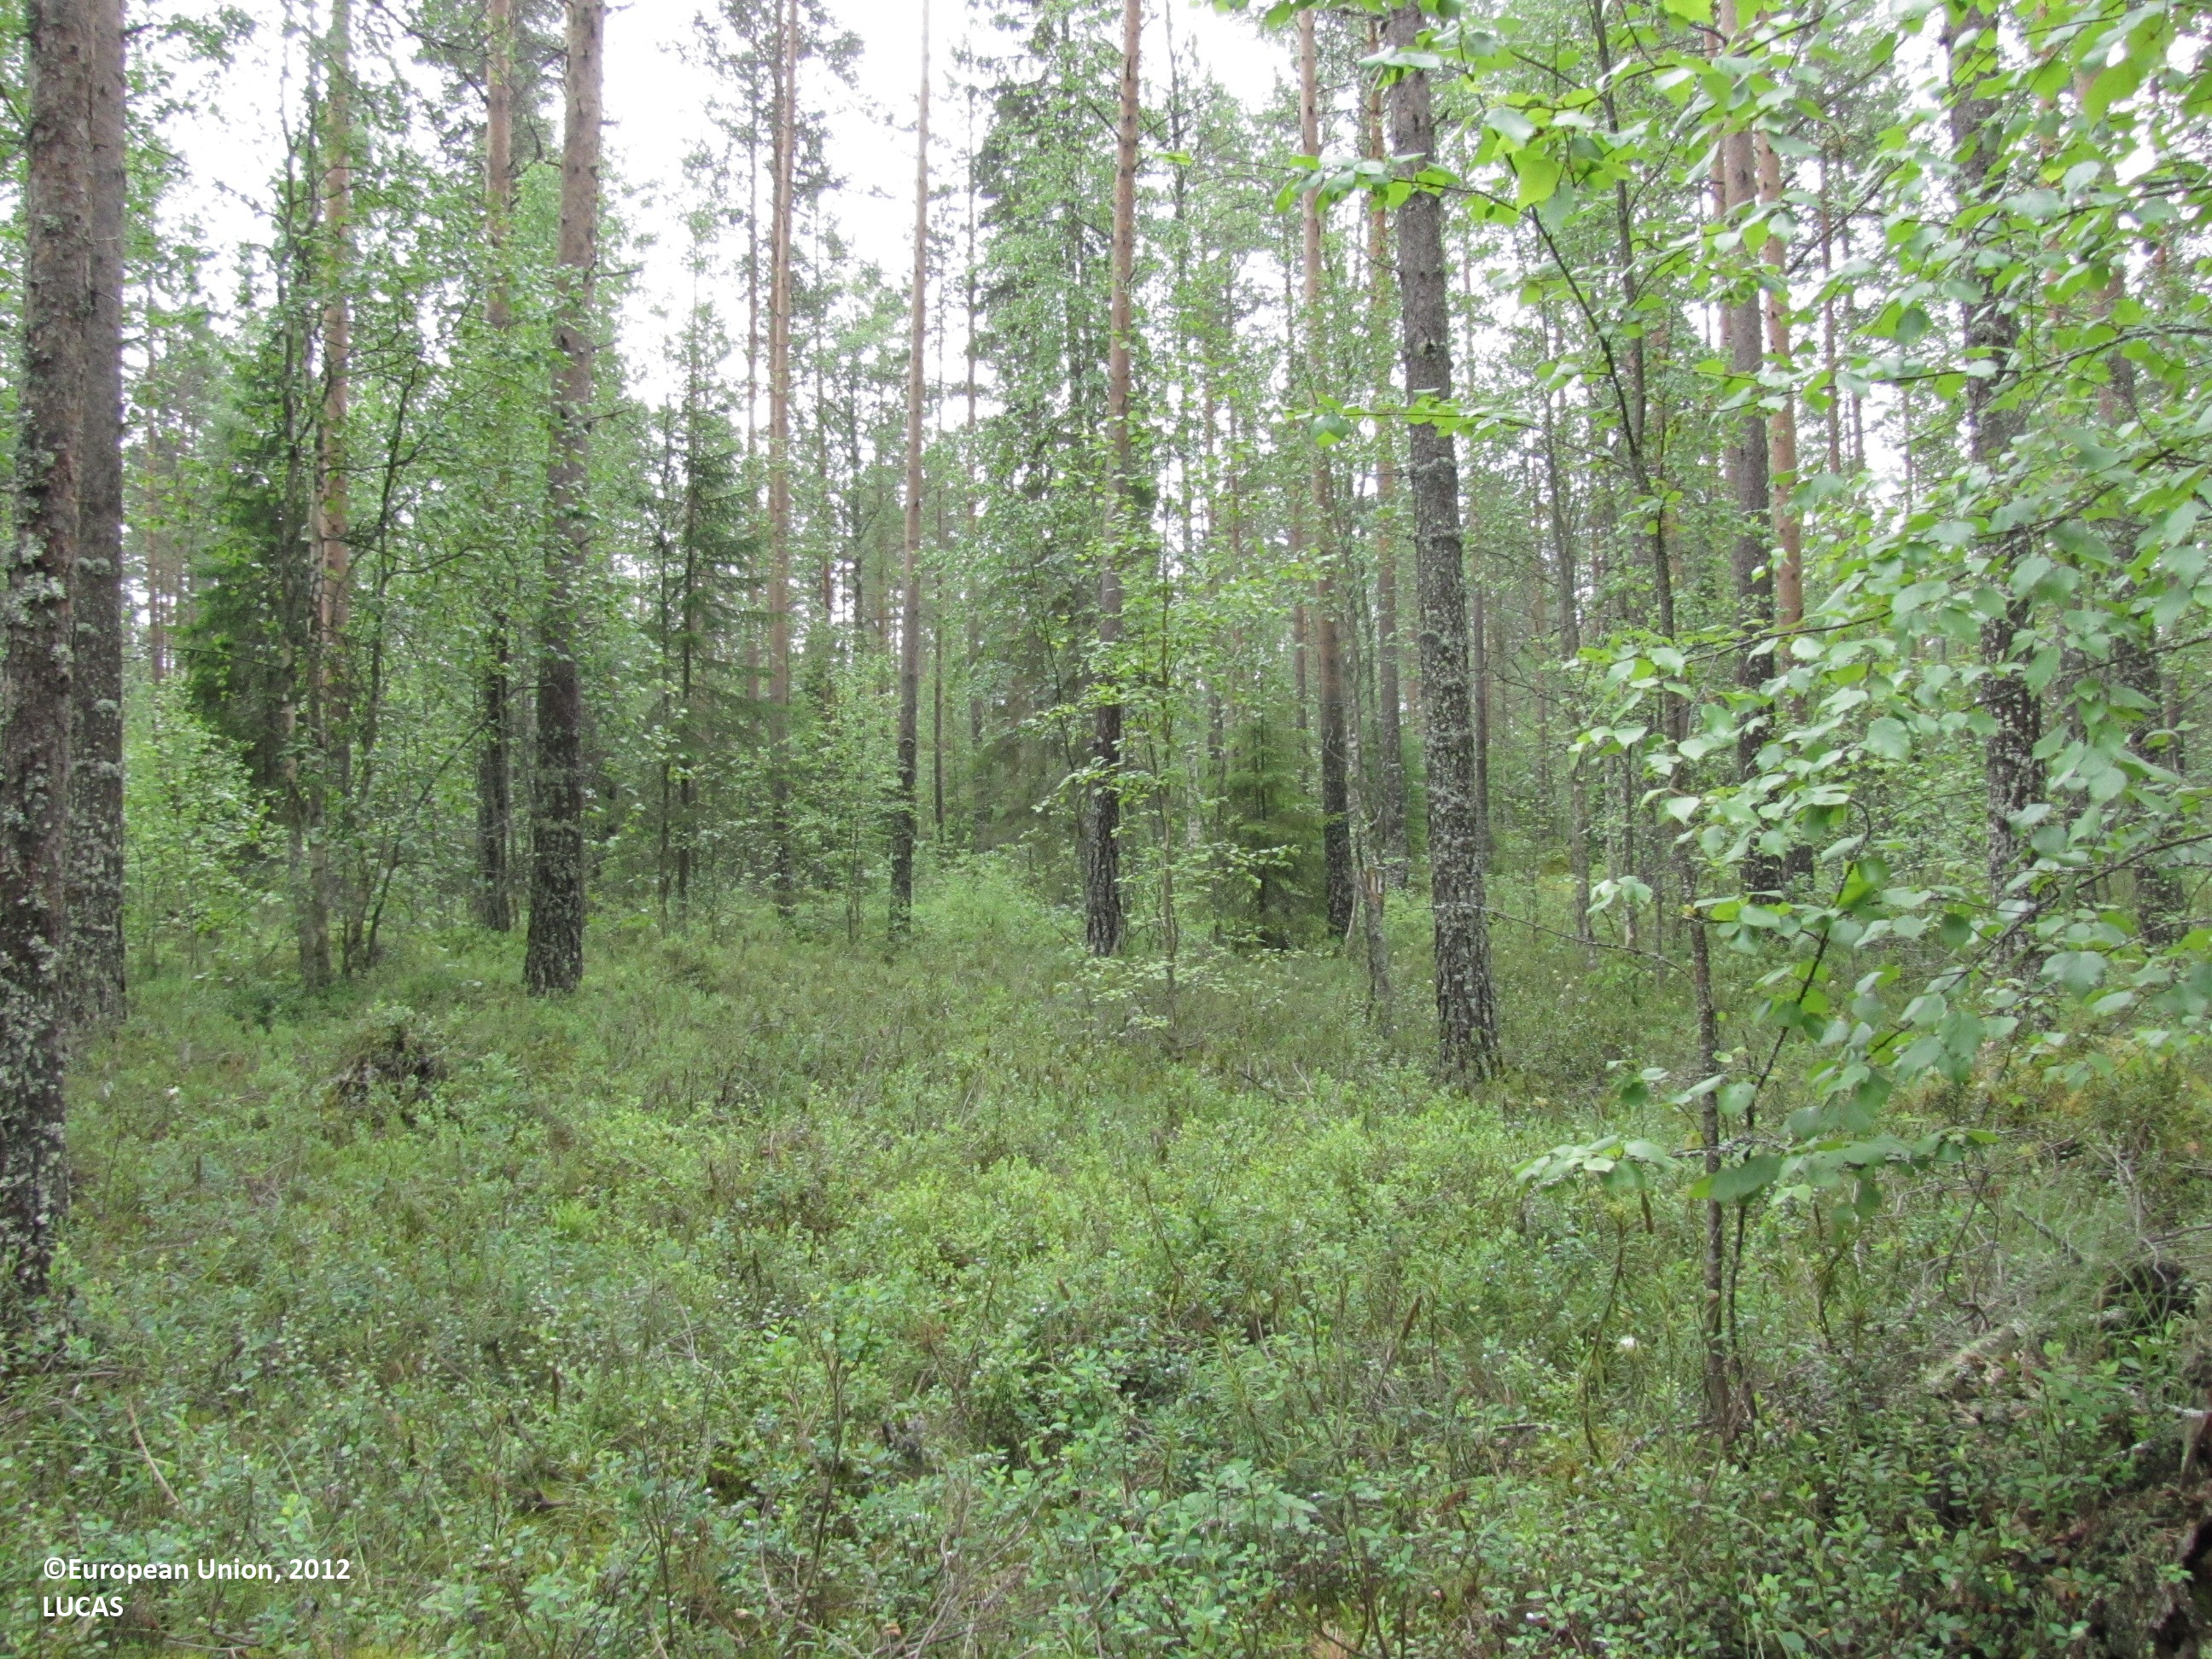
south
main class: Woodland
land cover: Pine dominated coniferous woodland
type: mire and swamp forests
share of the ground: > 75 %
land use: Community services
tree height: > 5 m
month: July
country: FI
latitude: 62.3464
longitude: 23.9277
